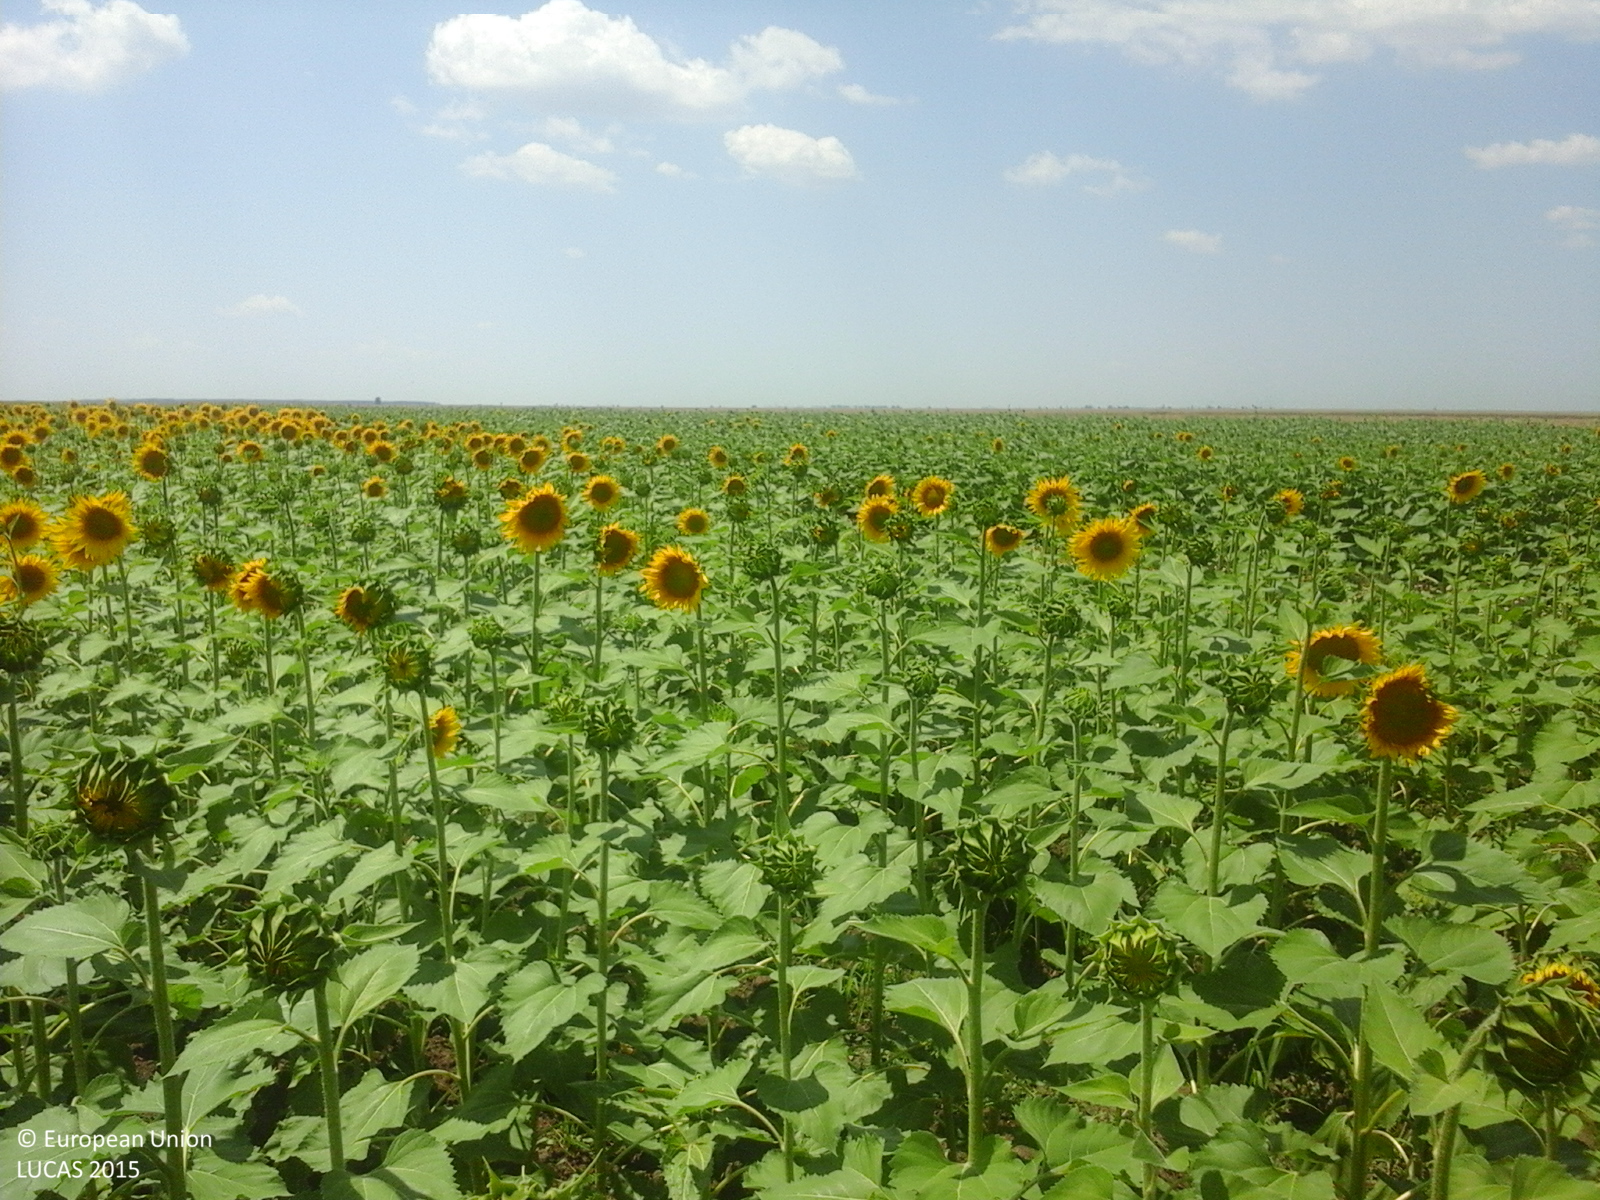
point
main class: Cropland
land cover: Sunflower
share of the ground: > 75 %
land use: Agriculture (excluding fallow land and kitchen gardens)
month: July
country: RO
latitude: 44.1731
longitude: 24.7184
